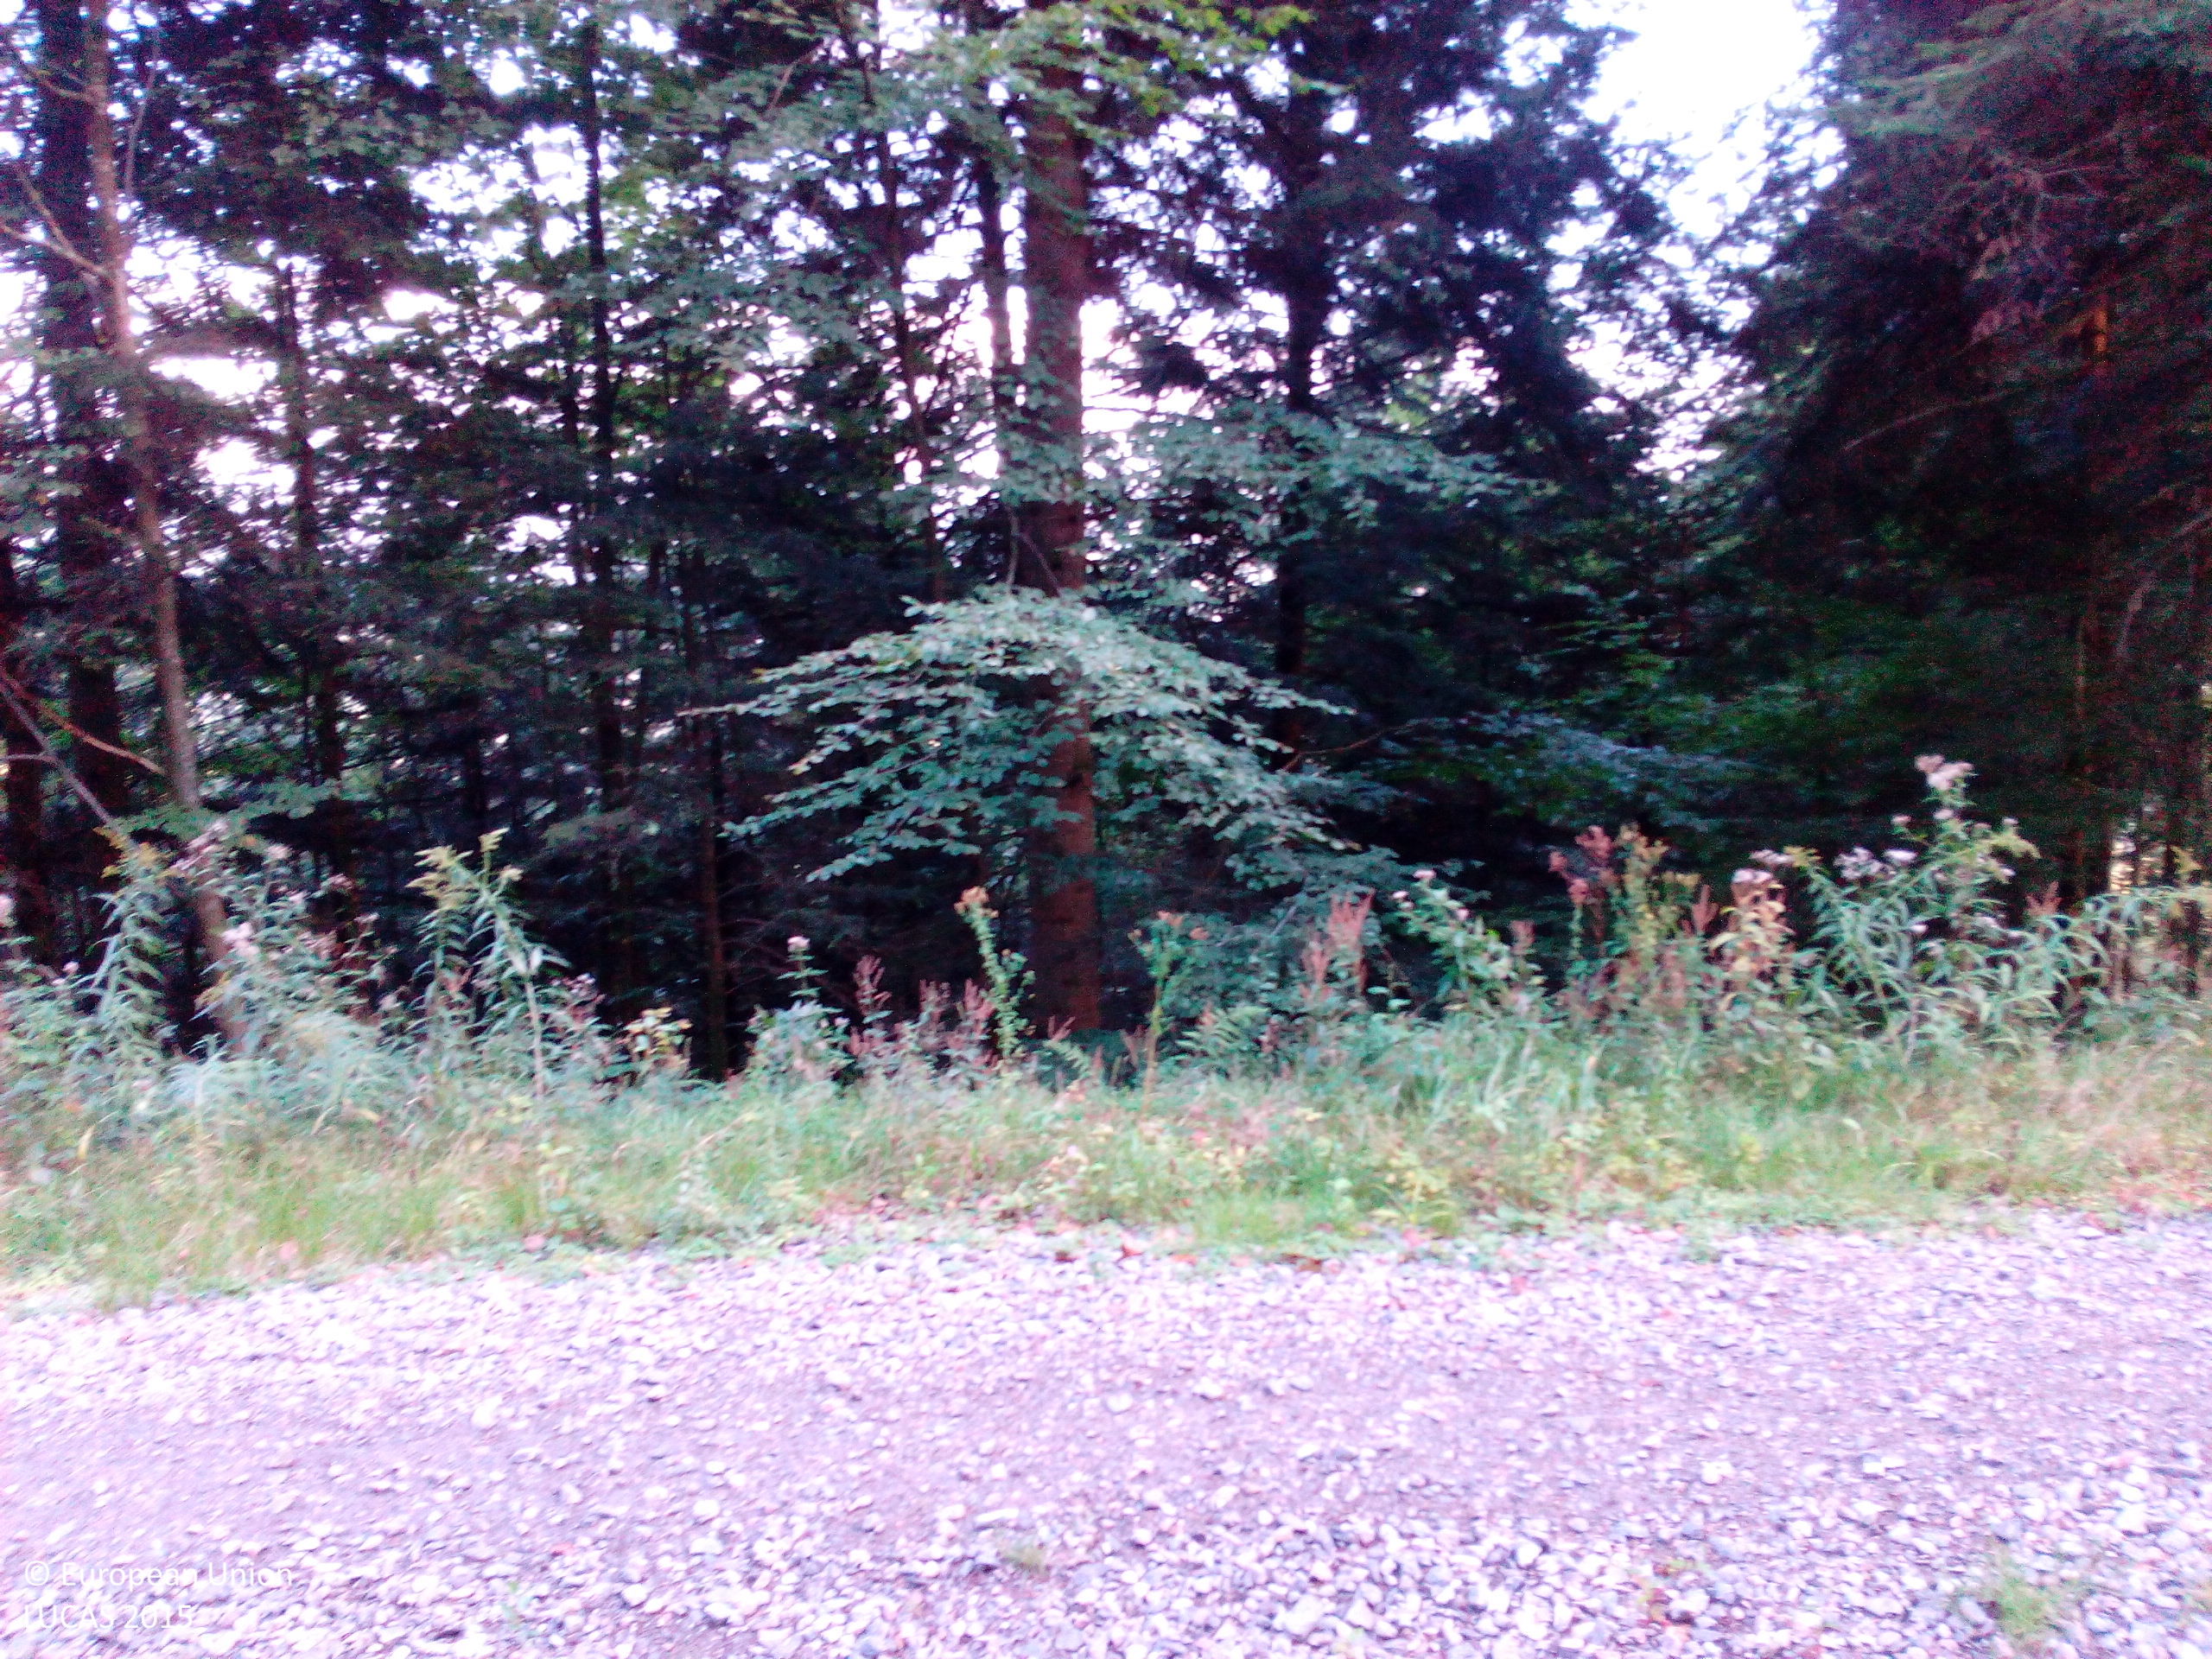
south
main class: Woodland
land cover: Other mixed woodland
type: hemiboreal forest and nemoral coniferous forest and mixed broadleaved-coniferous forest
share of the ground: 50 - 75 %
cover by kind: coniferous forest trees 50 %, broadleaved forest trees 25 %, lichens and mosses 25 %
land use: Forestry
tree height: > 5 m
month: September
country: DE
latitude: 48.2972
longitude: 8.1002
